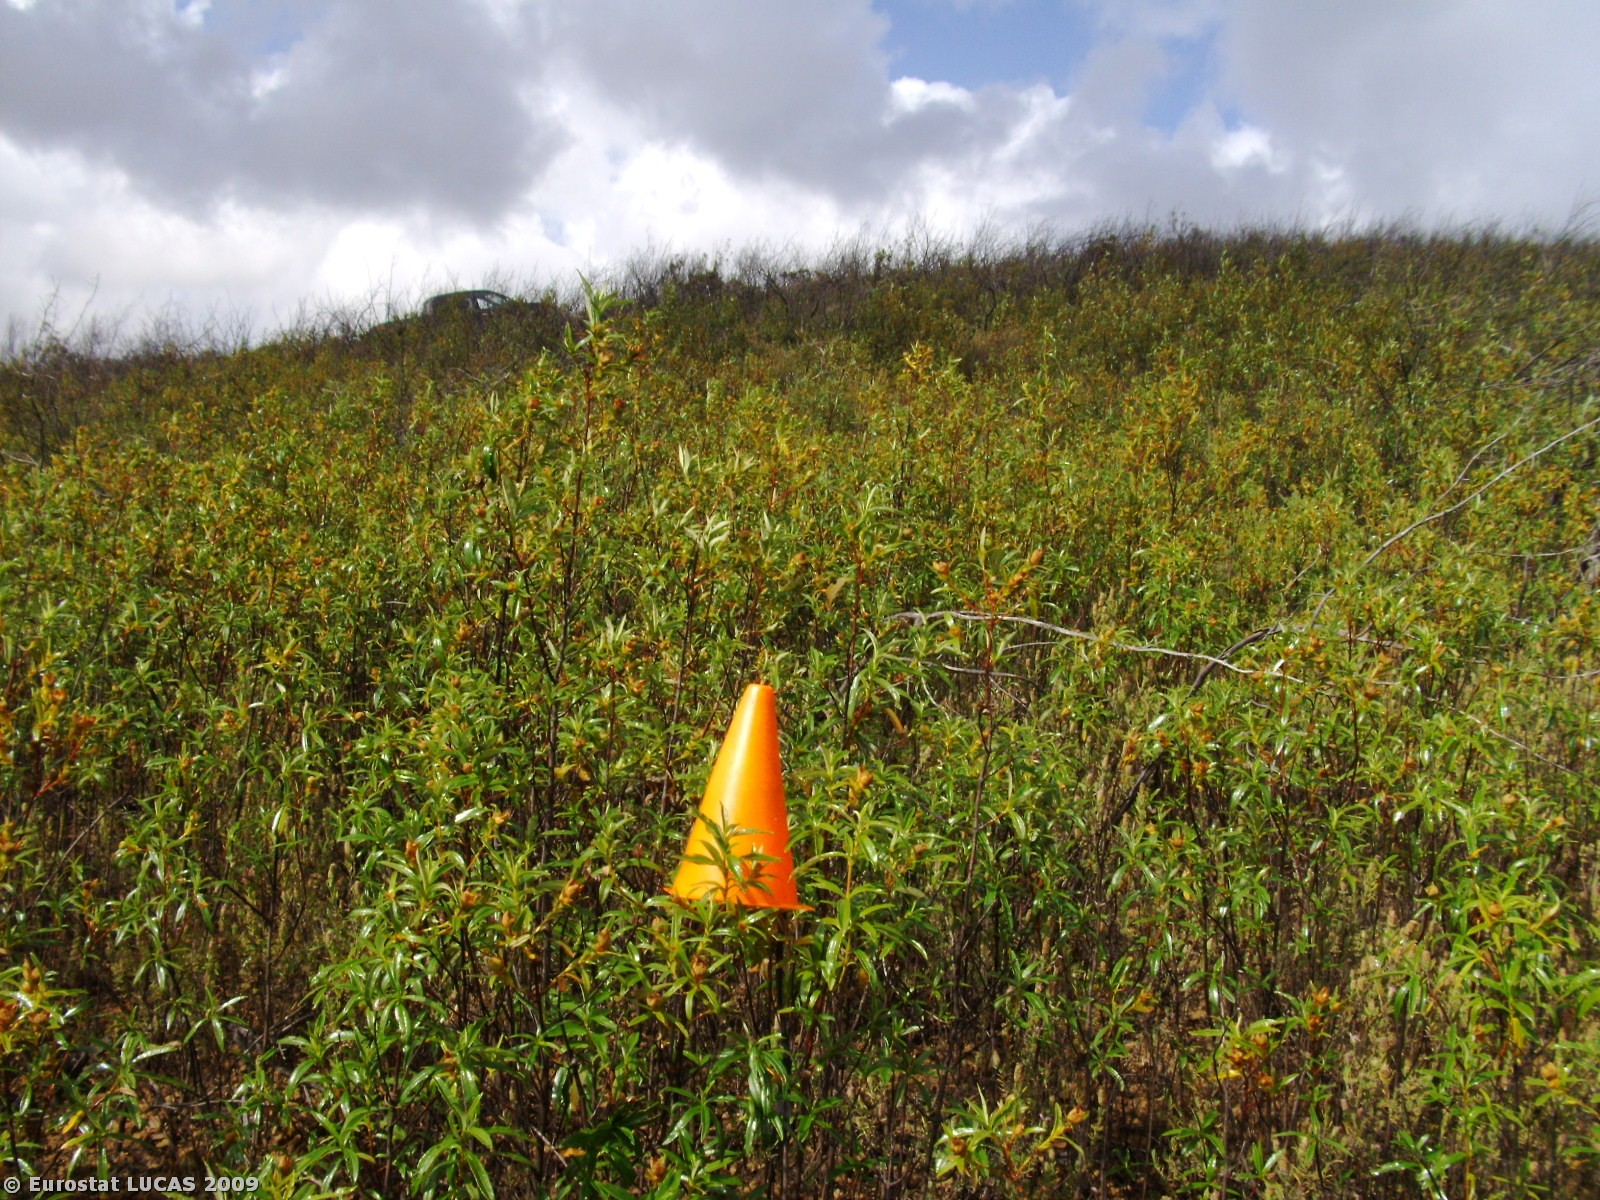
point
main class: Shrubland
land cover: Shrubland without tree cover
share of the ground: > 75 %
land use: Unused
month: June
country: PT
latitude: 37.2050
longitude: -8.7241
